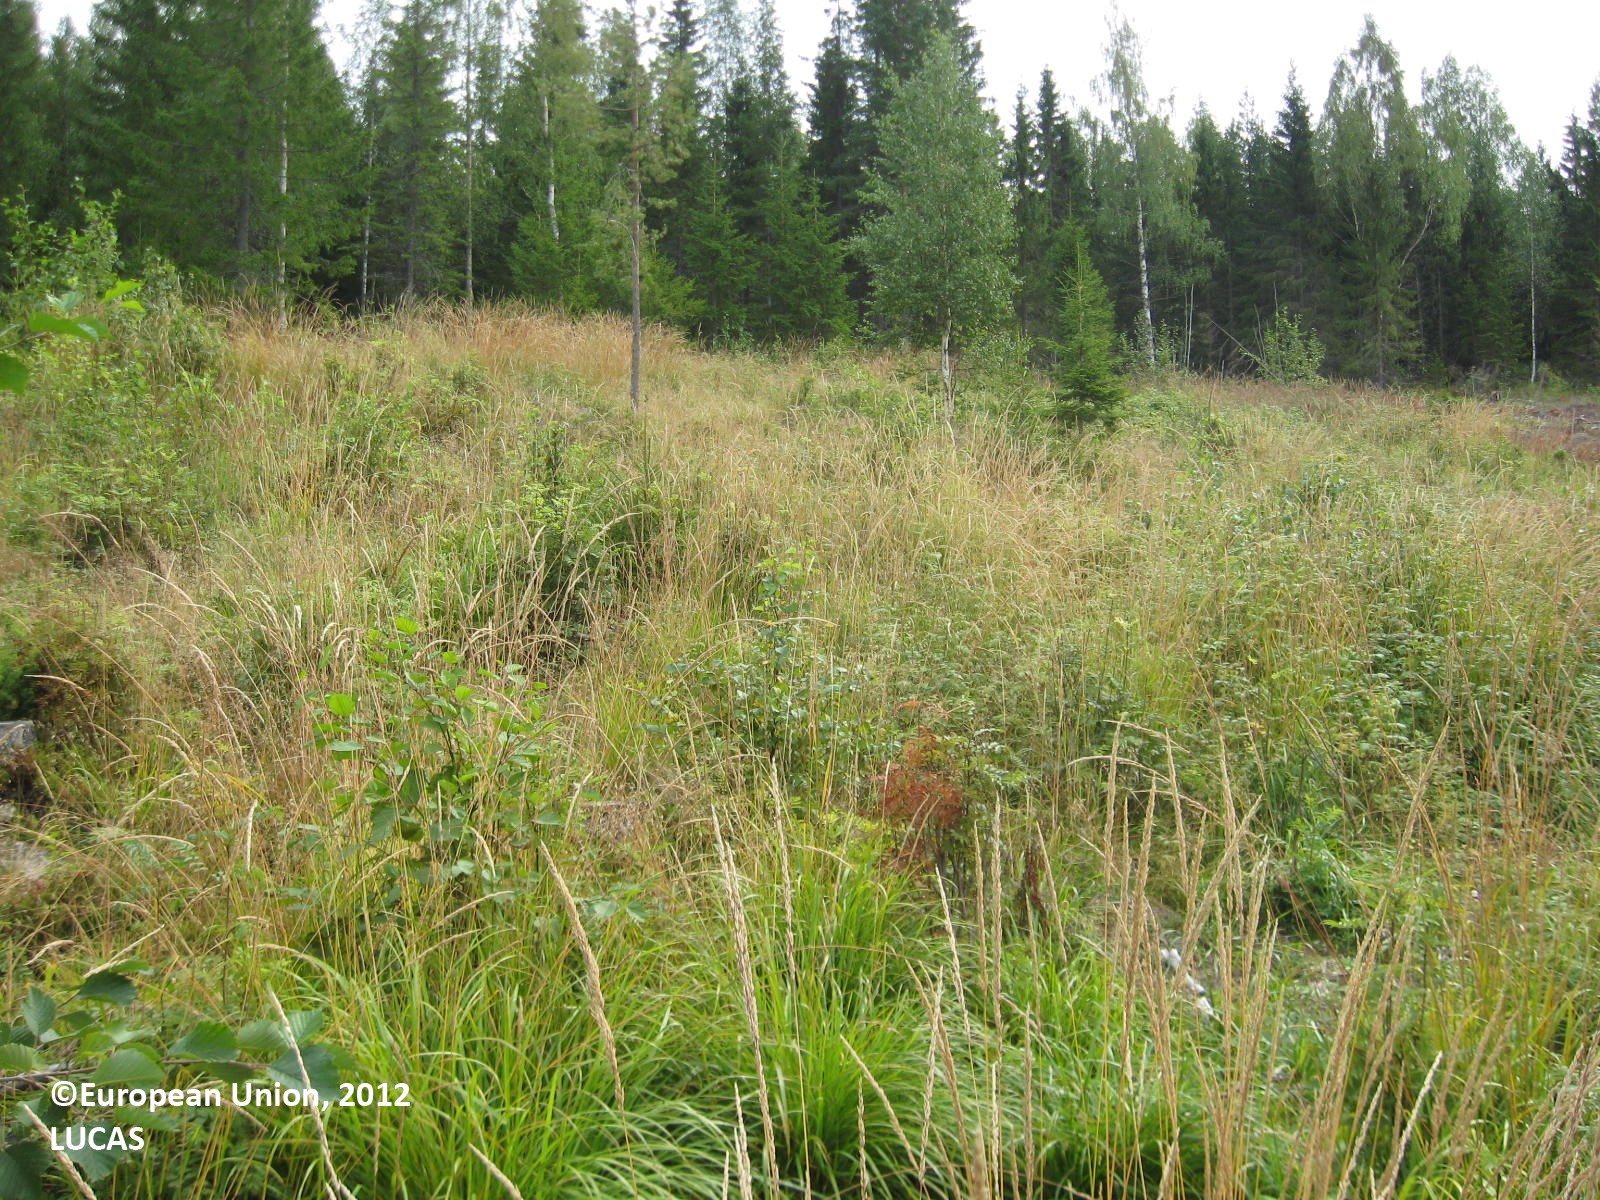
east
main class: Woodland
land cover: Other mixed woodland
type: boreal forest
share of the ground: 50 - 75 %
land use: Forestry
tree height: < 5 m
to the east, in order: Other mixed woodland; Spruce dominated coniferous woodland; Other coniferous woodland
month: August
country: FI
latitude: 63.4439
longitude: 29.5361
